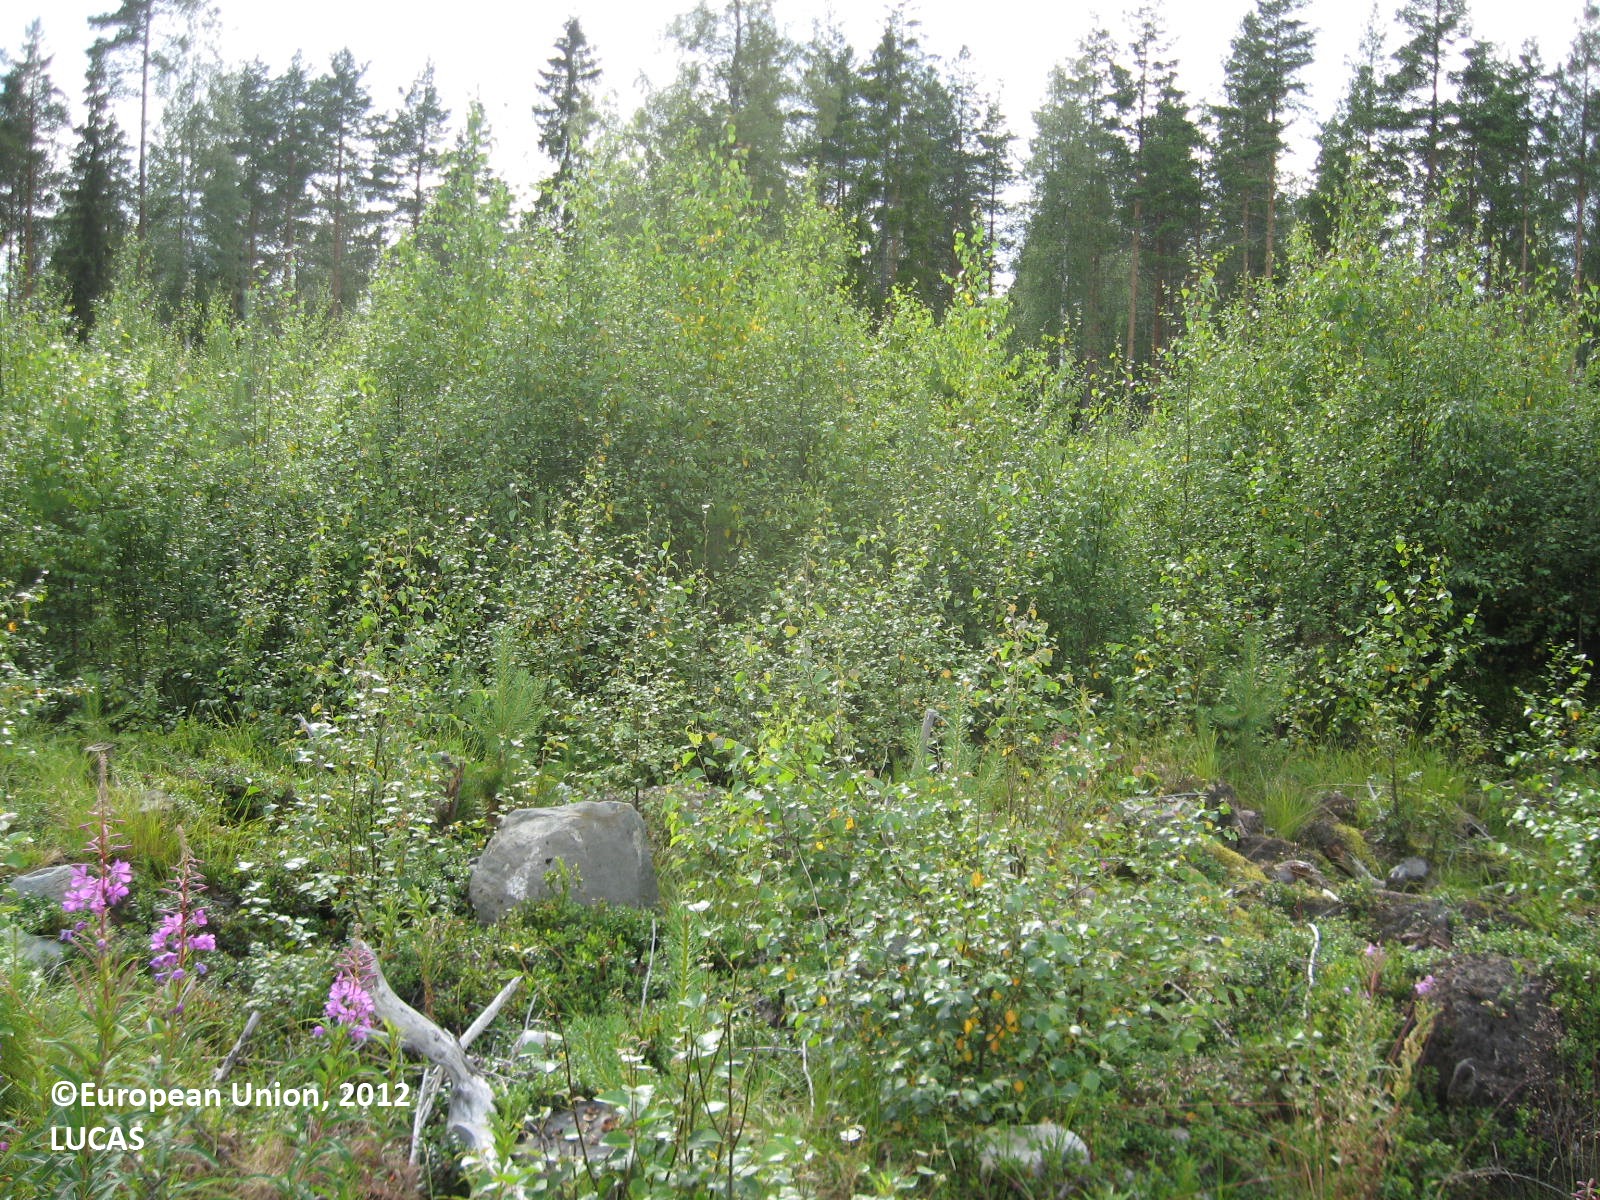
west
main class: Grassland
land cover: Grassland with sparse tree/shrub cover
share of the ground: 10 - 25 %
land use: Forestry
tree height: < 5 m
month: July
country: FI
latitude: 62.2121
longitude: 22.3422
